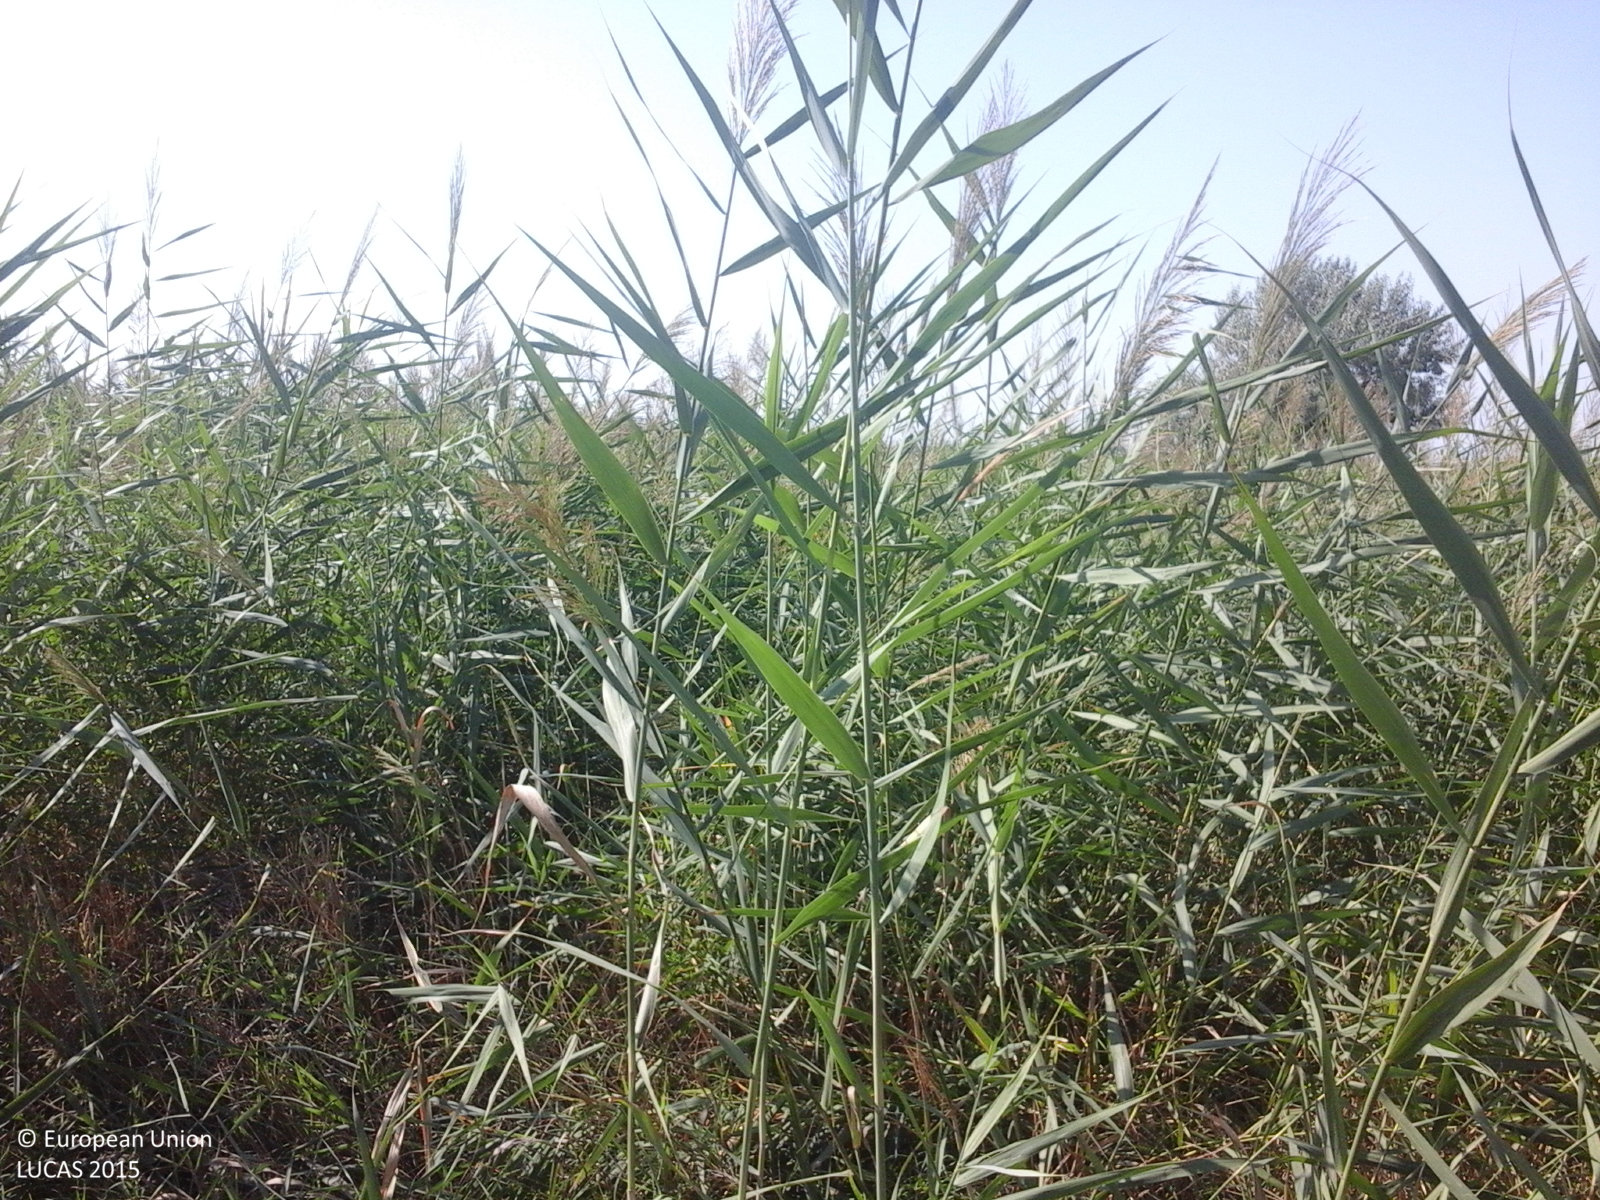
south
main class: Grassland
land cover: Spontaneously vegetated surfaces
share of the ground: > 75 %
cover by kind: herbaceous plants 100 %
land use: Semi-natural and natural areas not in use
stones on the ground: < 10 %
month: August
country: RO
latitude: 43.9627
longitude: 22.8889
